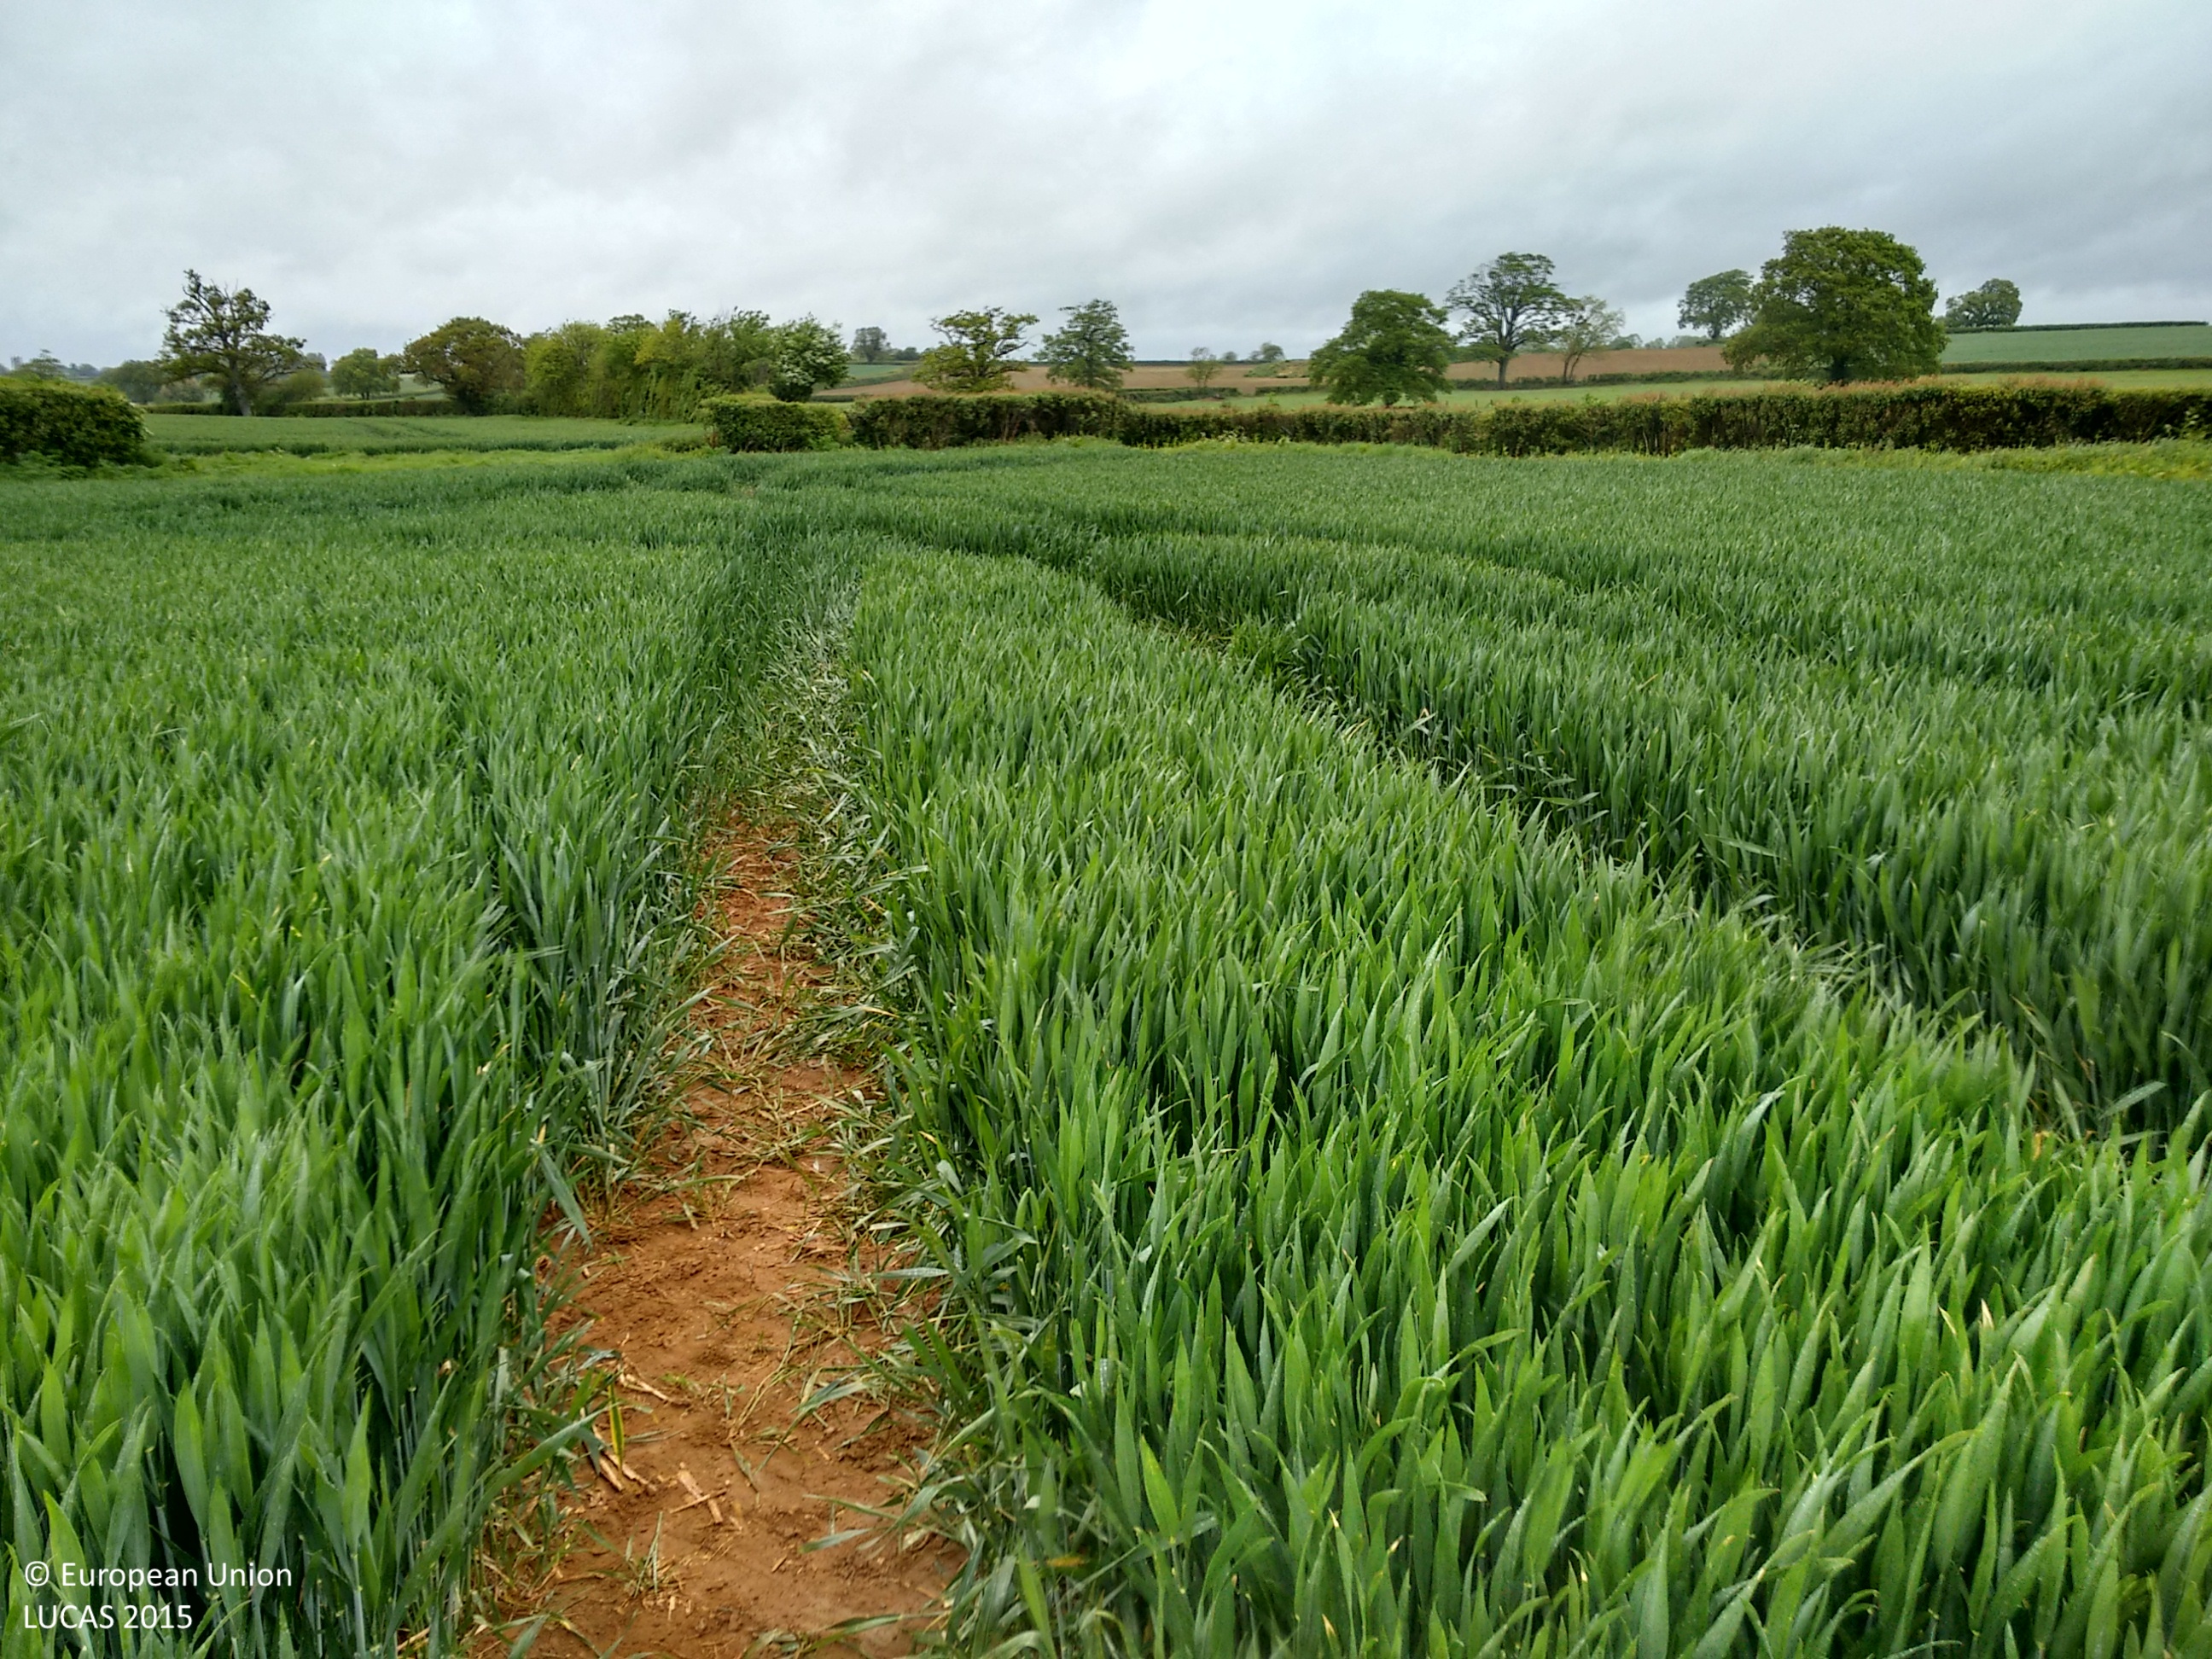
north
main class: Cropland
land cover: Common wheat
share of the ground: > 75 %
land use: Agriculture (excluding fallow land and kitchen gardens)
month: May
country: GB
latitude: 50.9534
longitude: -2.2911
